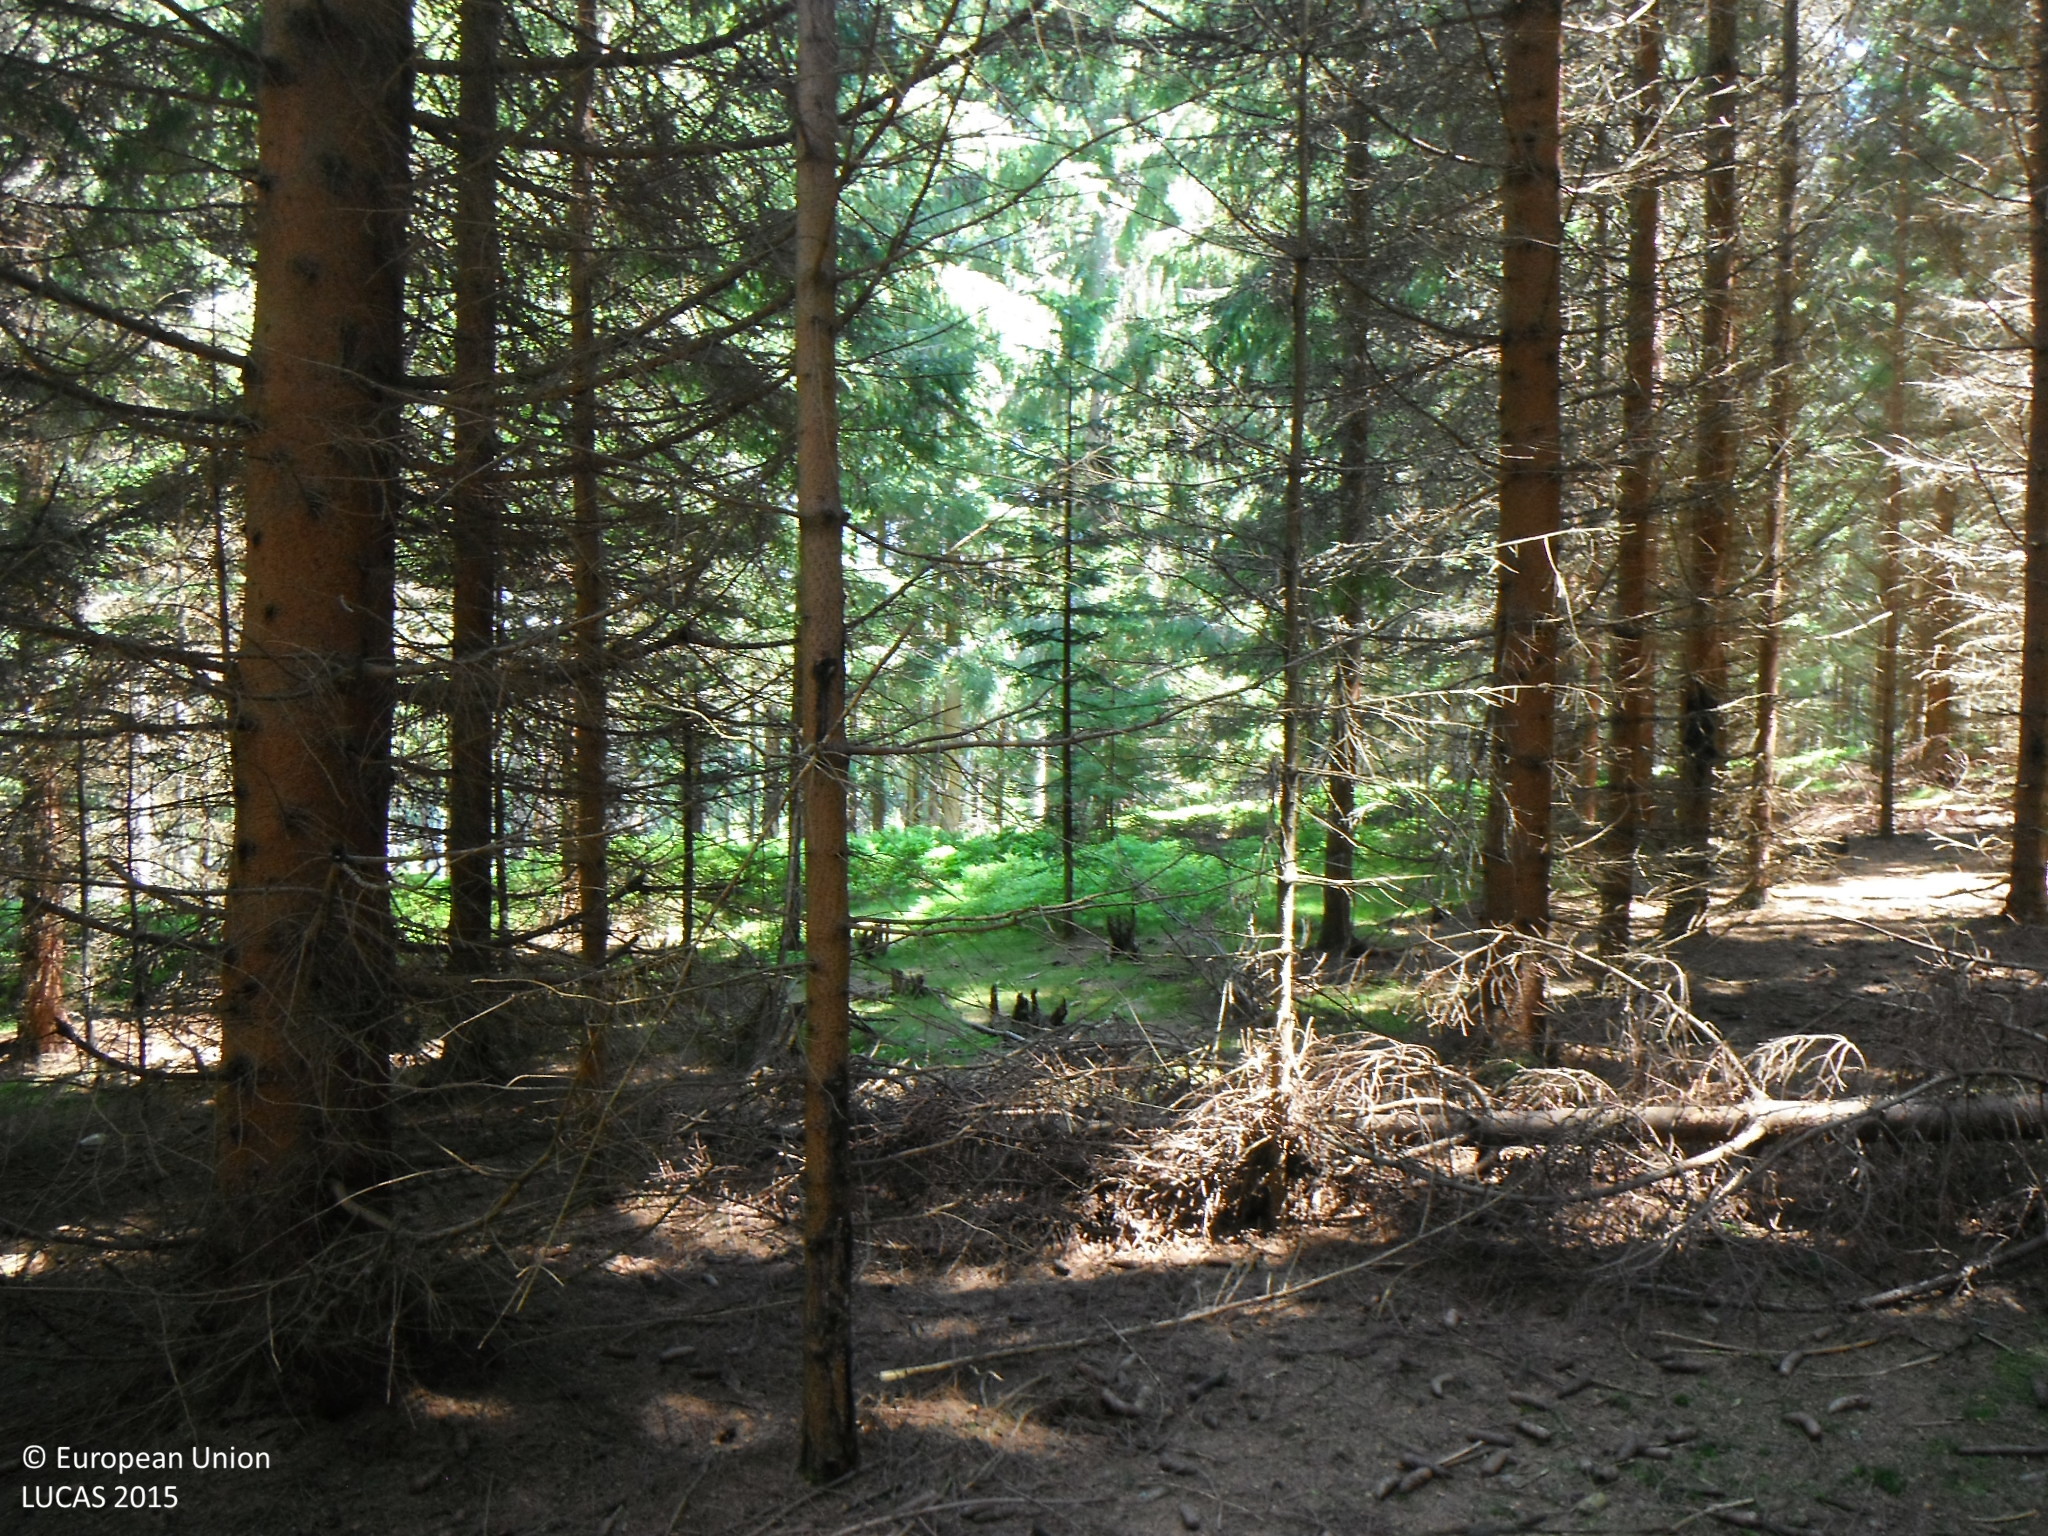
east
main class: Woodland
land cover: Spruce dominated coniferous woodland
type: alpine coniferous forest
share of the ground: > 75 %
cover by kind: coniferous forest trees 75 %, herbaceous plants 25 %
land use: Forestry
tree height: > 5 m
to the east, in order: Spruce dominated coniferous woodland; Tracks; Spruce dominated coniferous woodland
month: May
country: SK
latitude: 48.5772
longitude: 19.6636
